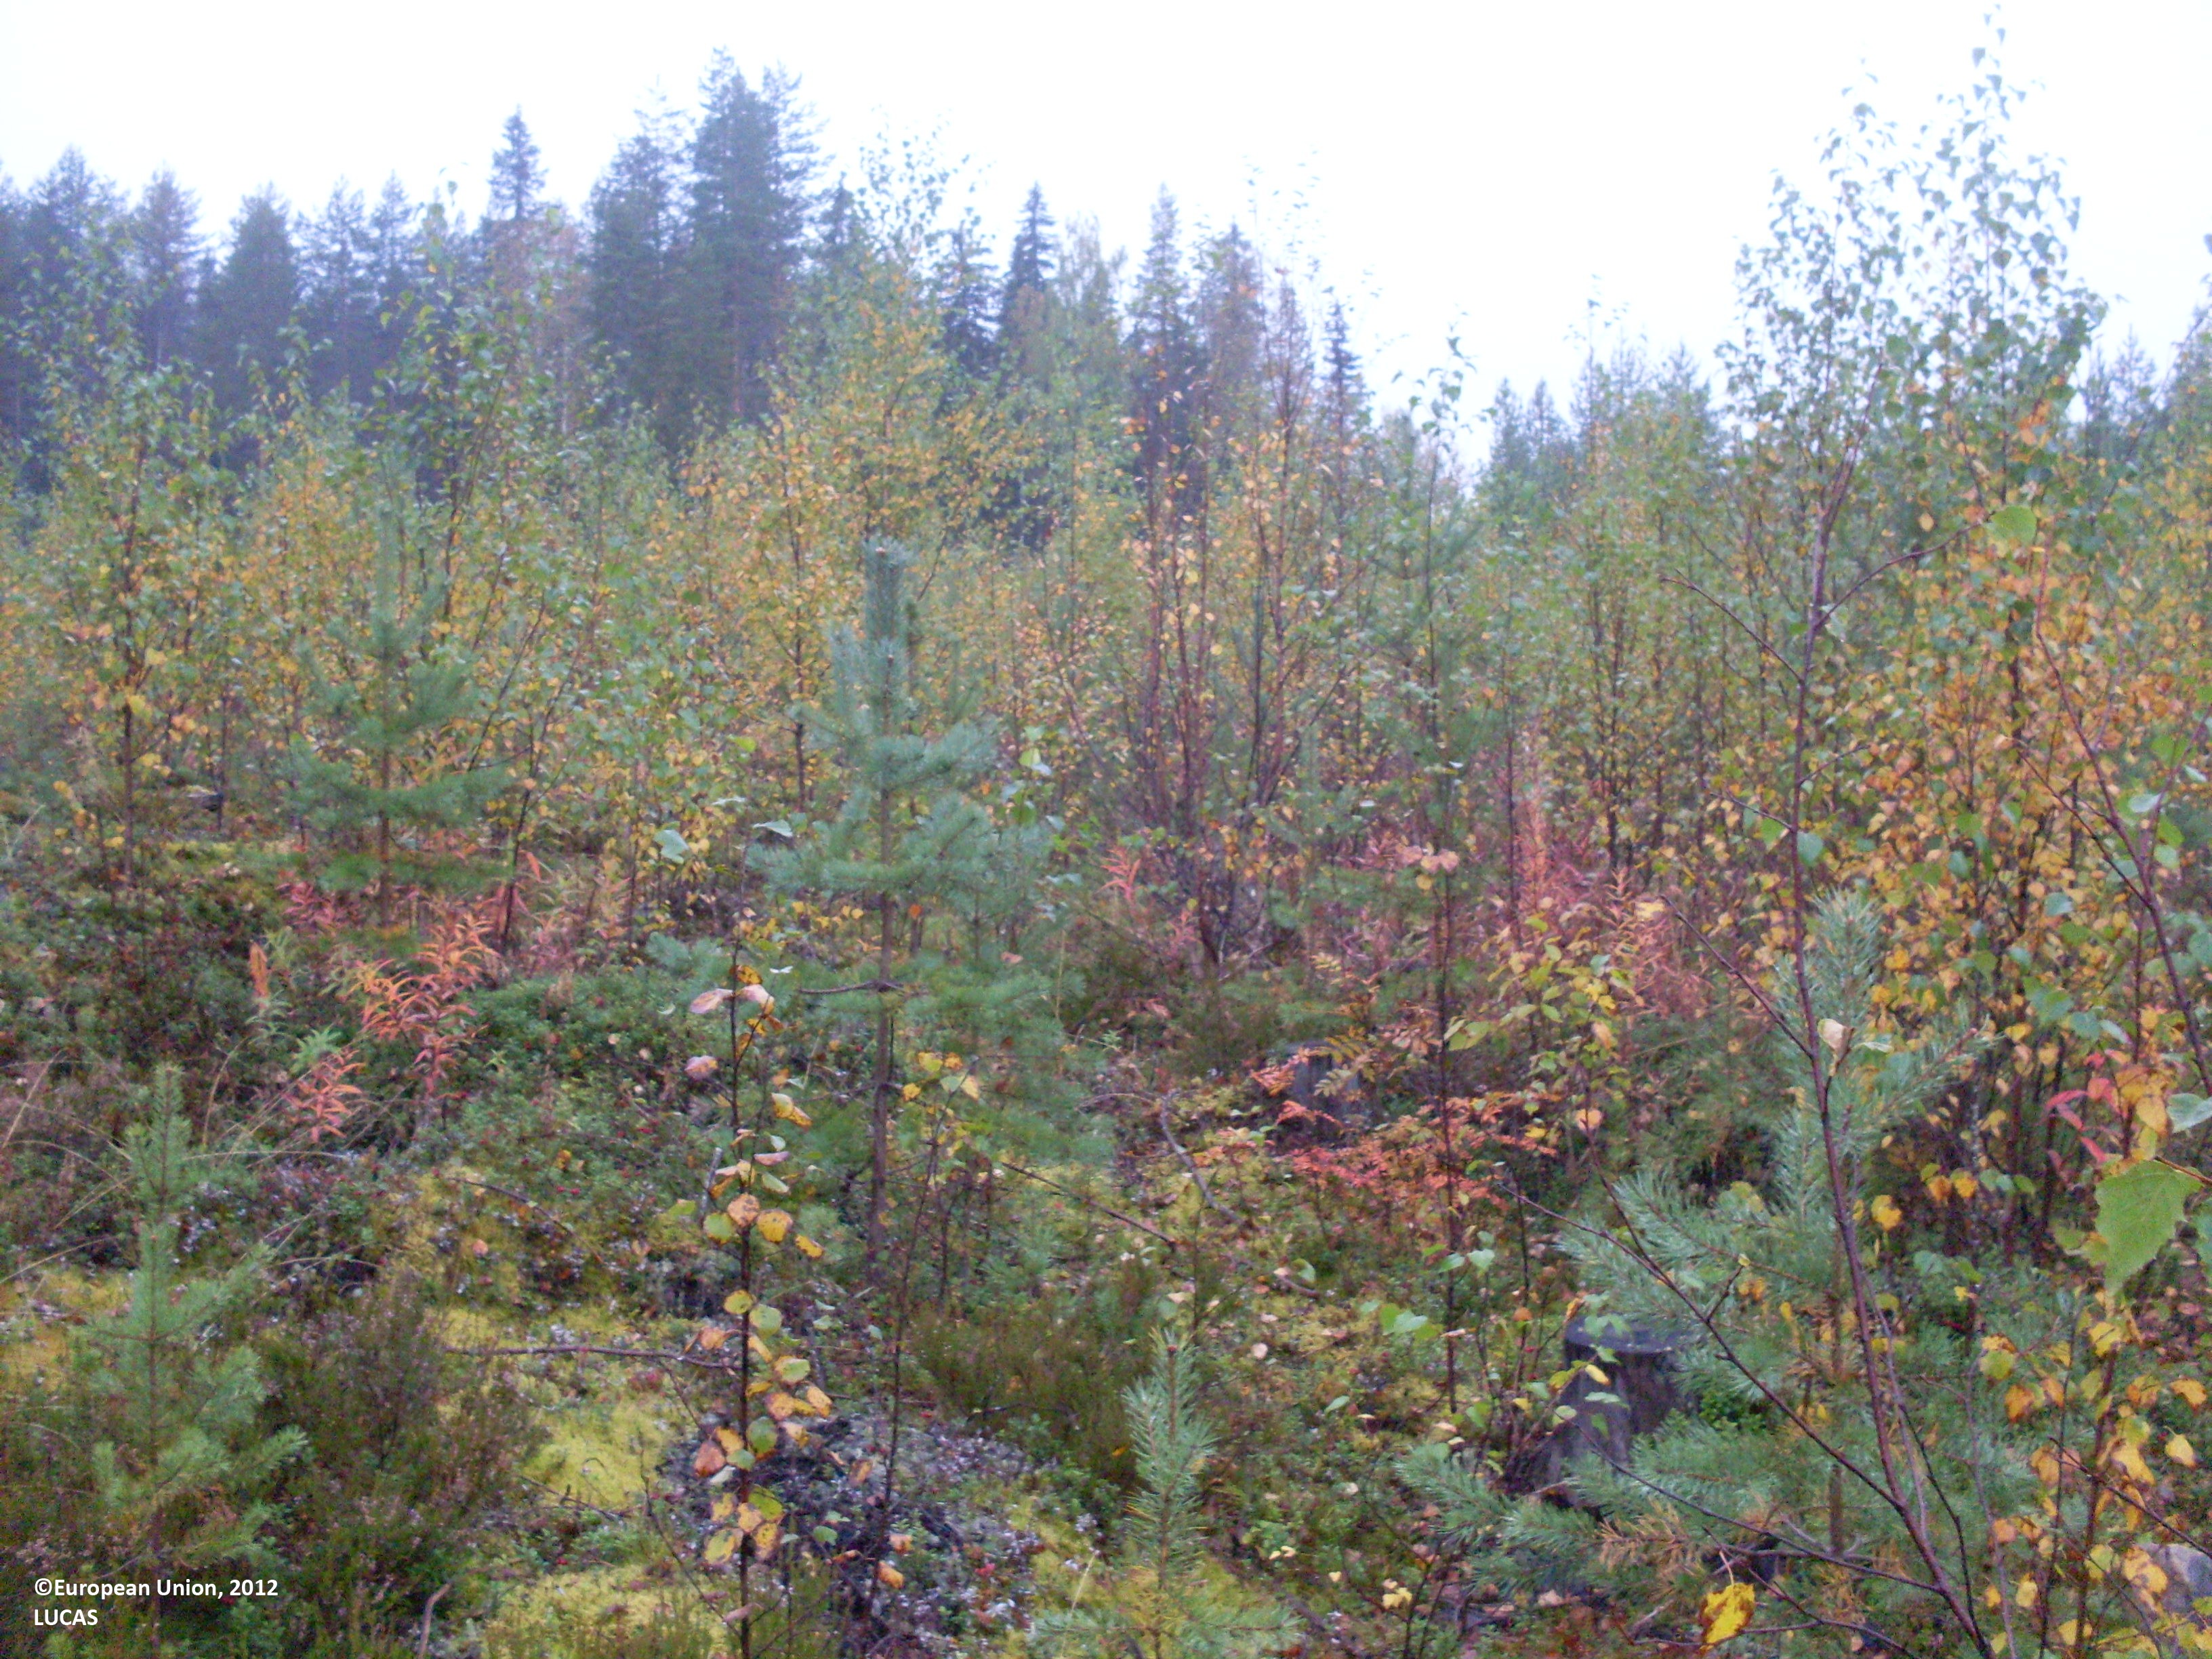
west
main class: Woodland
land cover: Pine dominated mixed woodland
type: boreal forest
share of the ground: 10 - 25 %
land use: Forestry
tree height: < 5 m
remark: Nursery
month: September
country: FI
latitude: 64.1670
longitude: 28.8489
